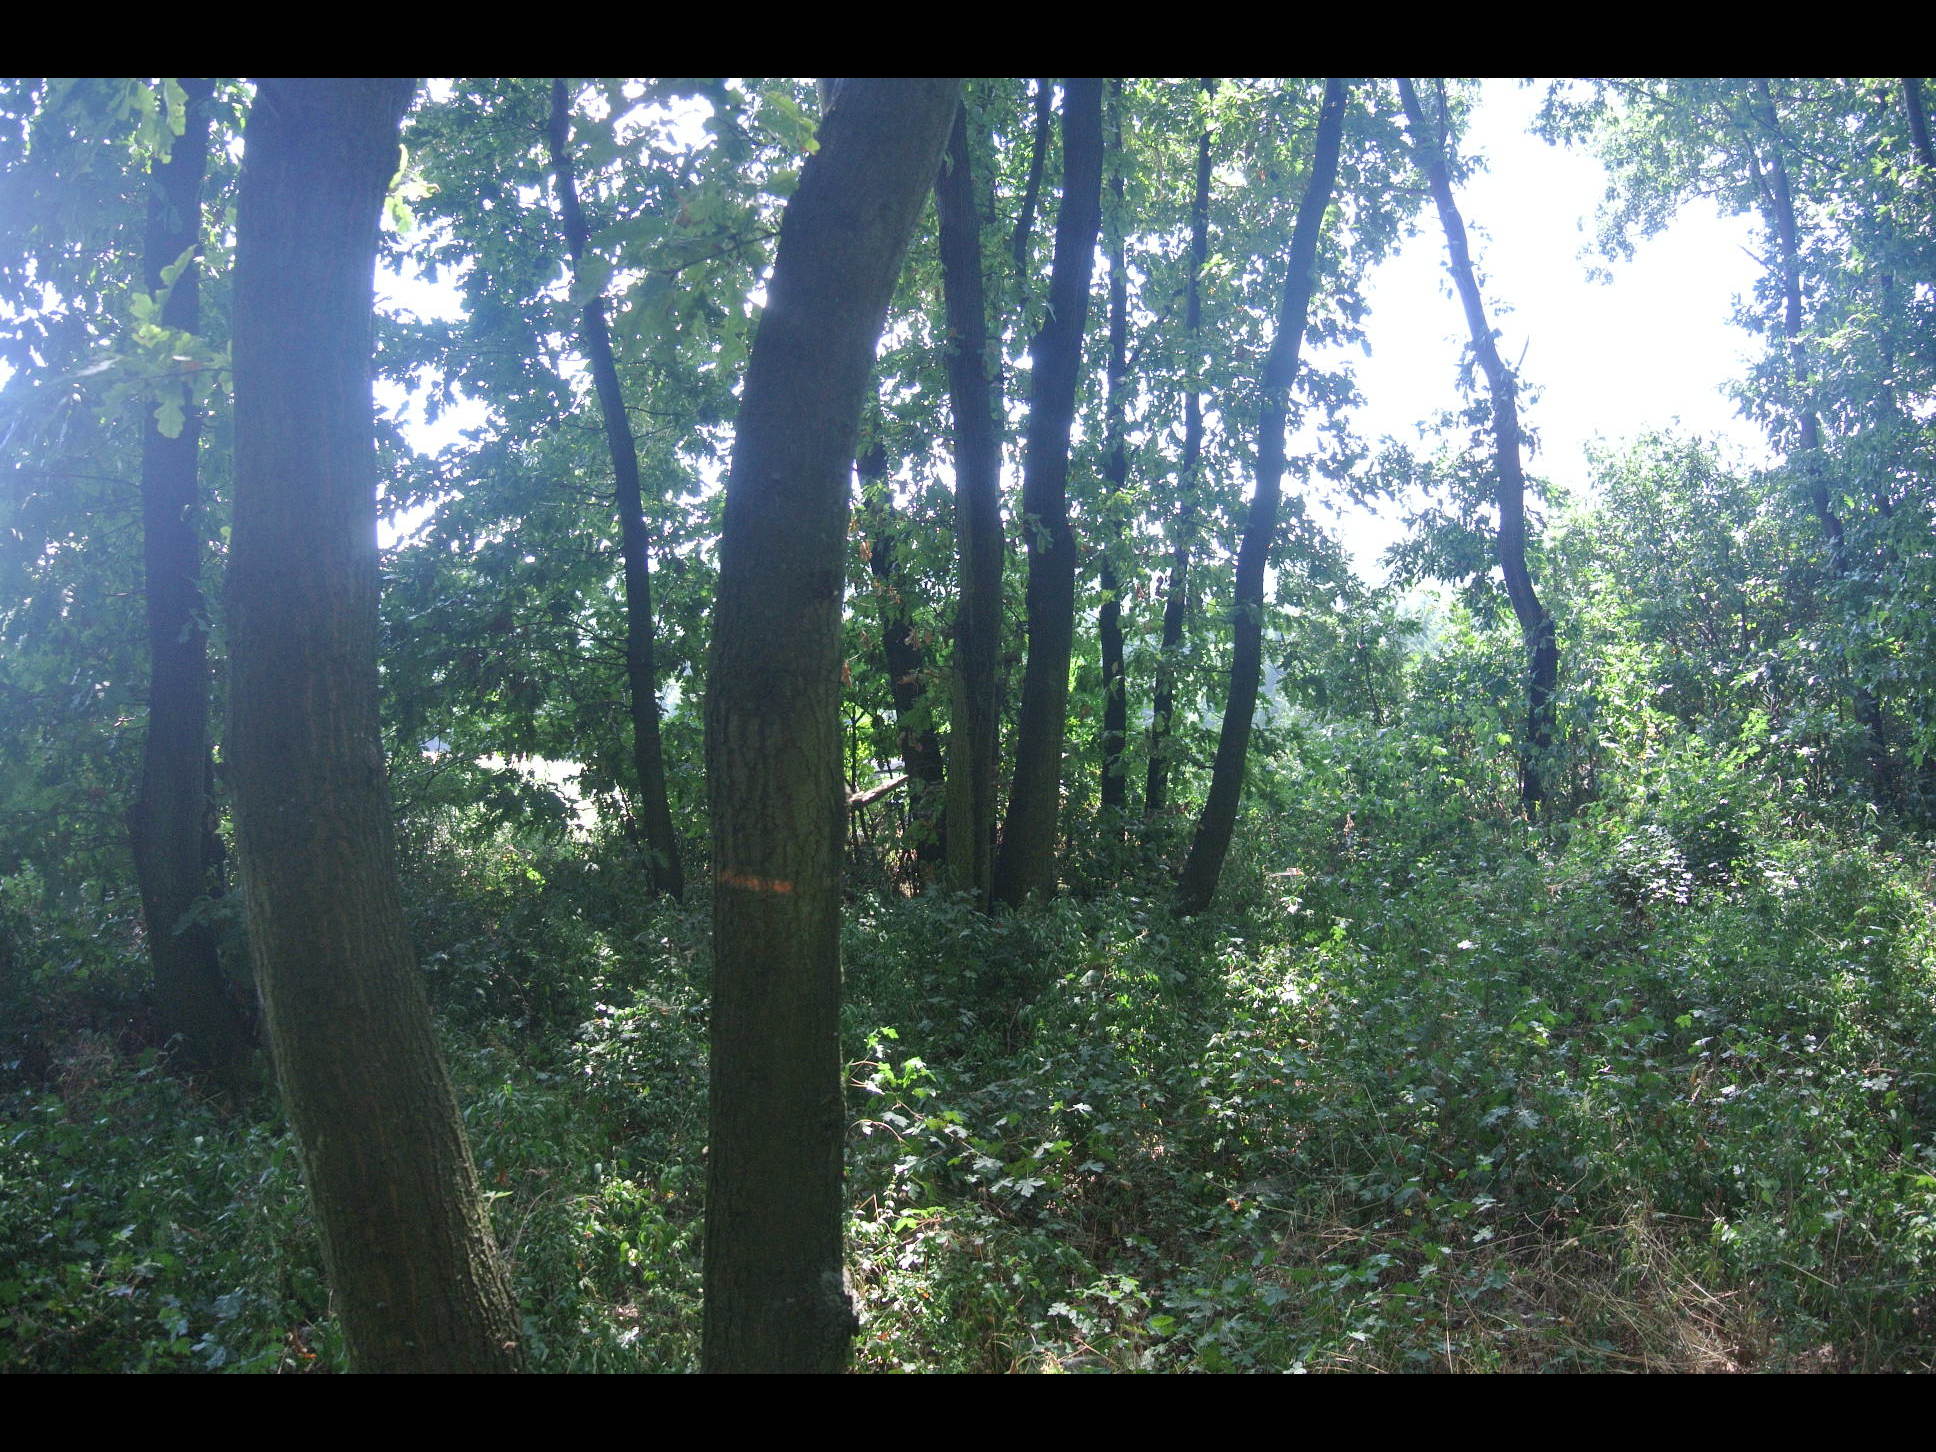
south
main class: Woodland
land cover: Broadleaved woodland
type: beech forest
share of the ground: > 75 %
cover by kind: broadleaved forest trees 100 %
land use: Forestry
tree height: > 5 m
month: July
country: AT
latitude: 47.5736
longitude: 16.6114
